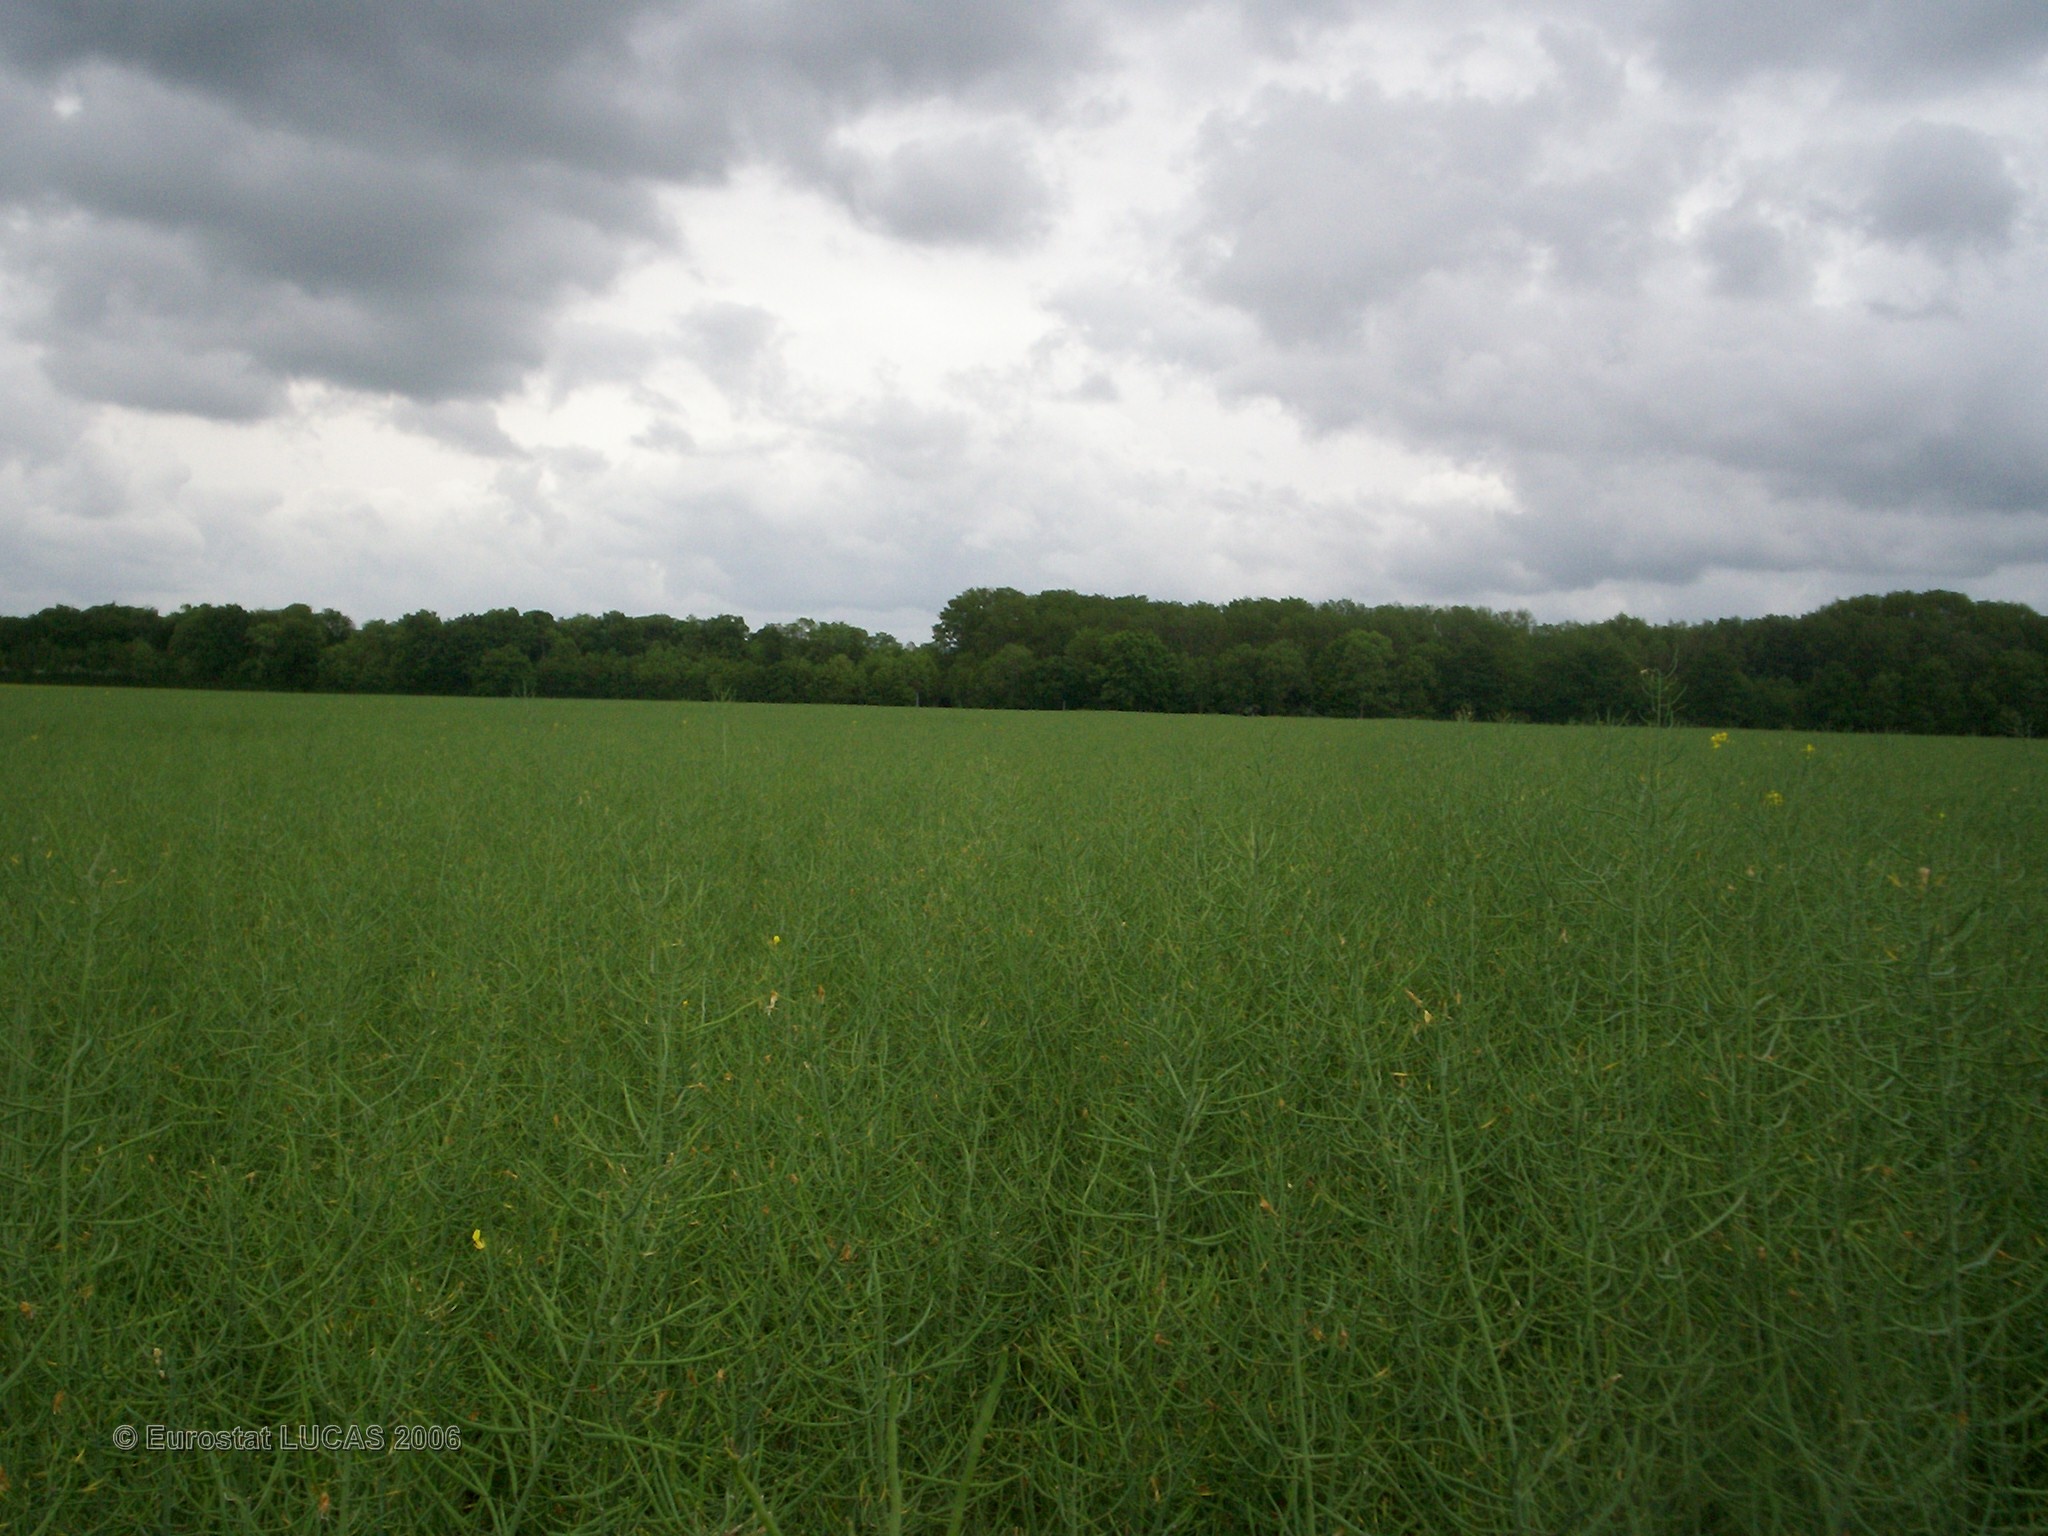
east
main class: Cropland
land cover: Rape and turnip rape
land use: Agriculture (excluding fallow land and kitchen gardens)
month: May
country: FR
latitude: 47.7833
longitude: 2.9863
